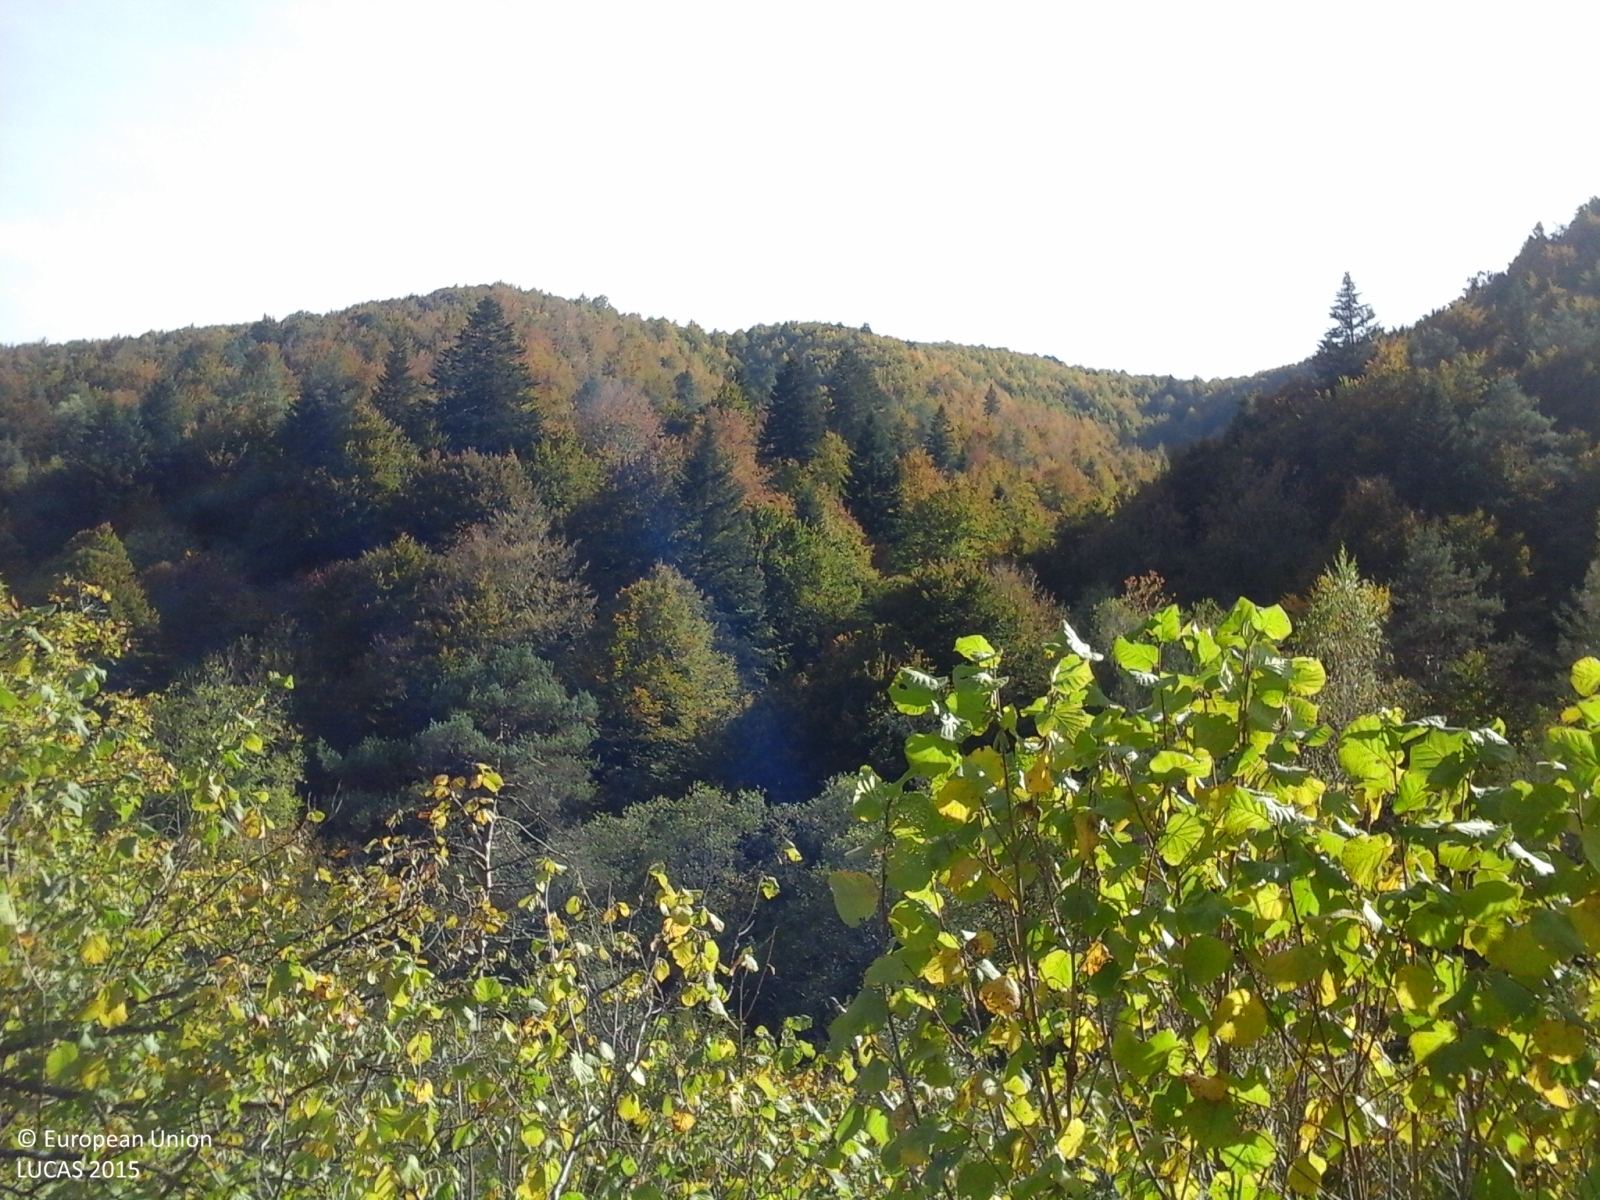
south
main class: Woodland
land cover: Broadleaved woodland
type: thermophilous deciduous forest
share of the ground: > 75 %
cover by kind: broadleaved forest trees 70 %, herbaceous plants 20 %, consolidated bare surface 10 %
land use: Semi-natural and natural areas not in use
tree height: < 5 m
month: October
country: IT
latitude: 44.1106
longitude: 7.7936
